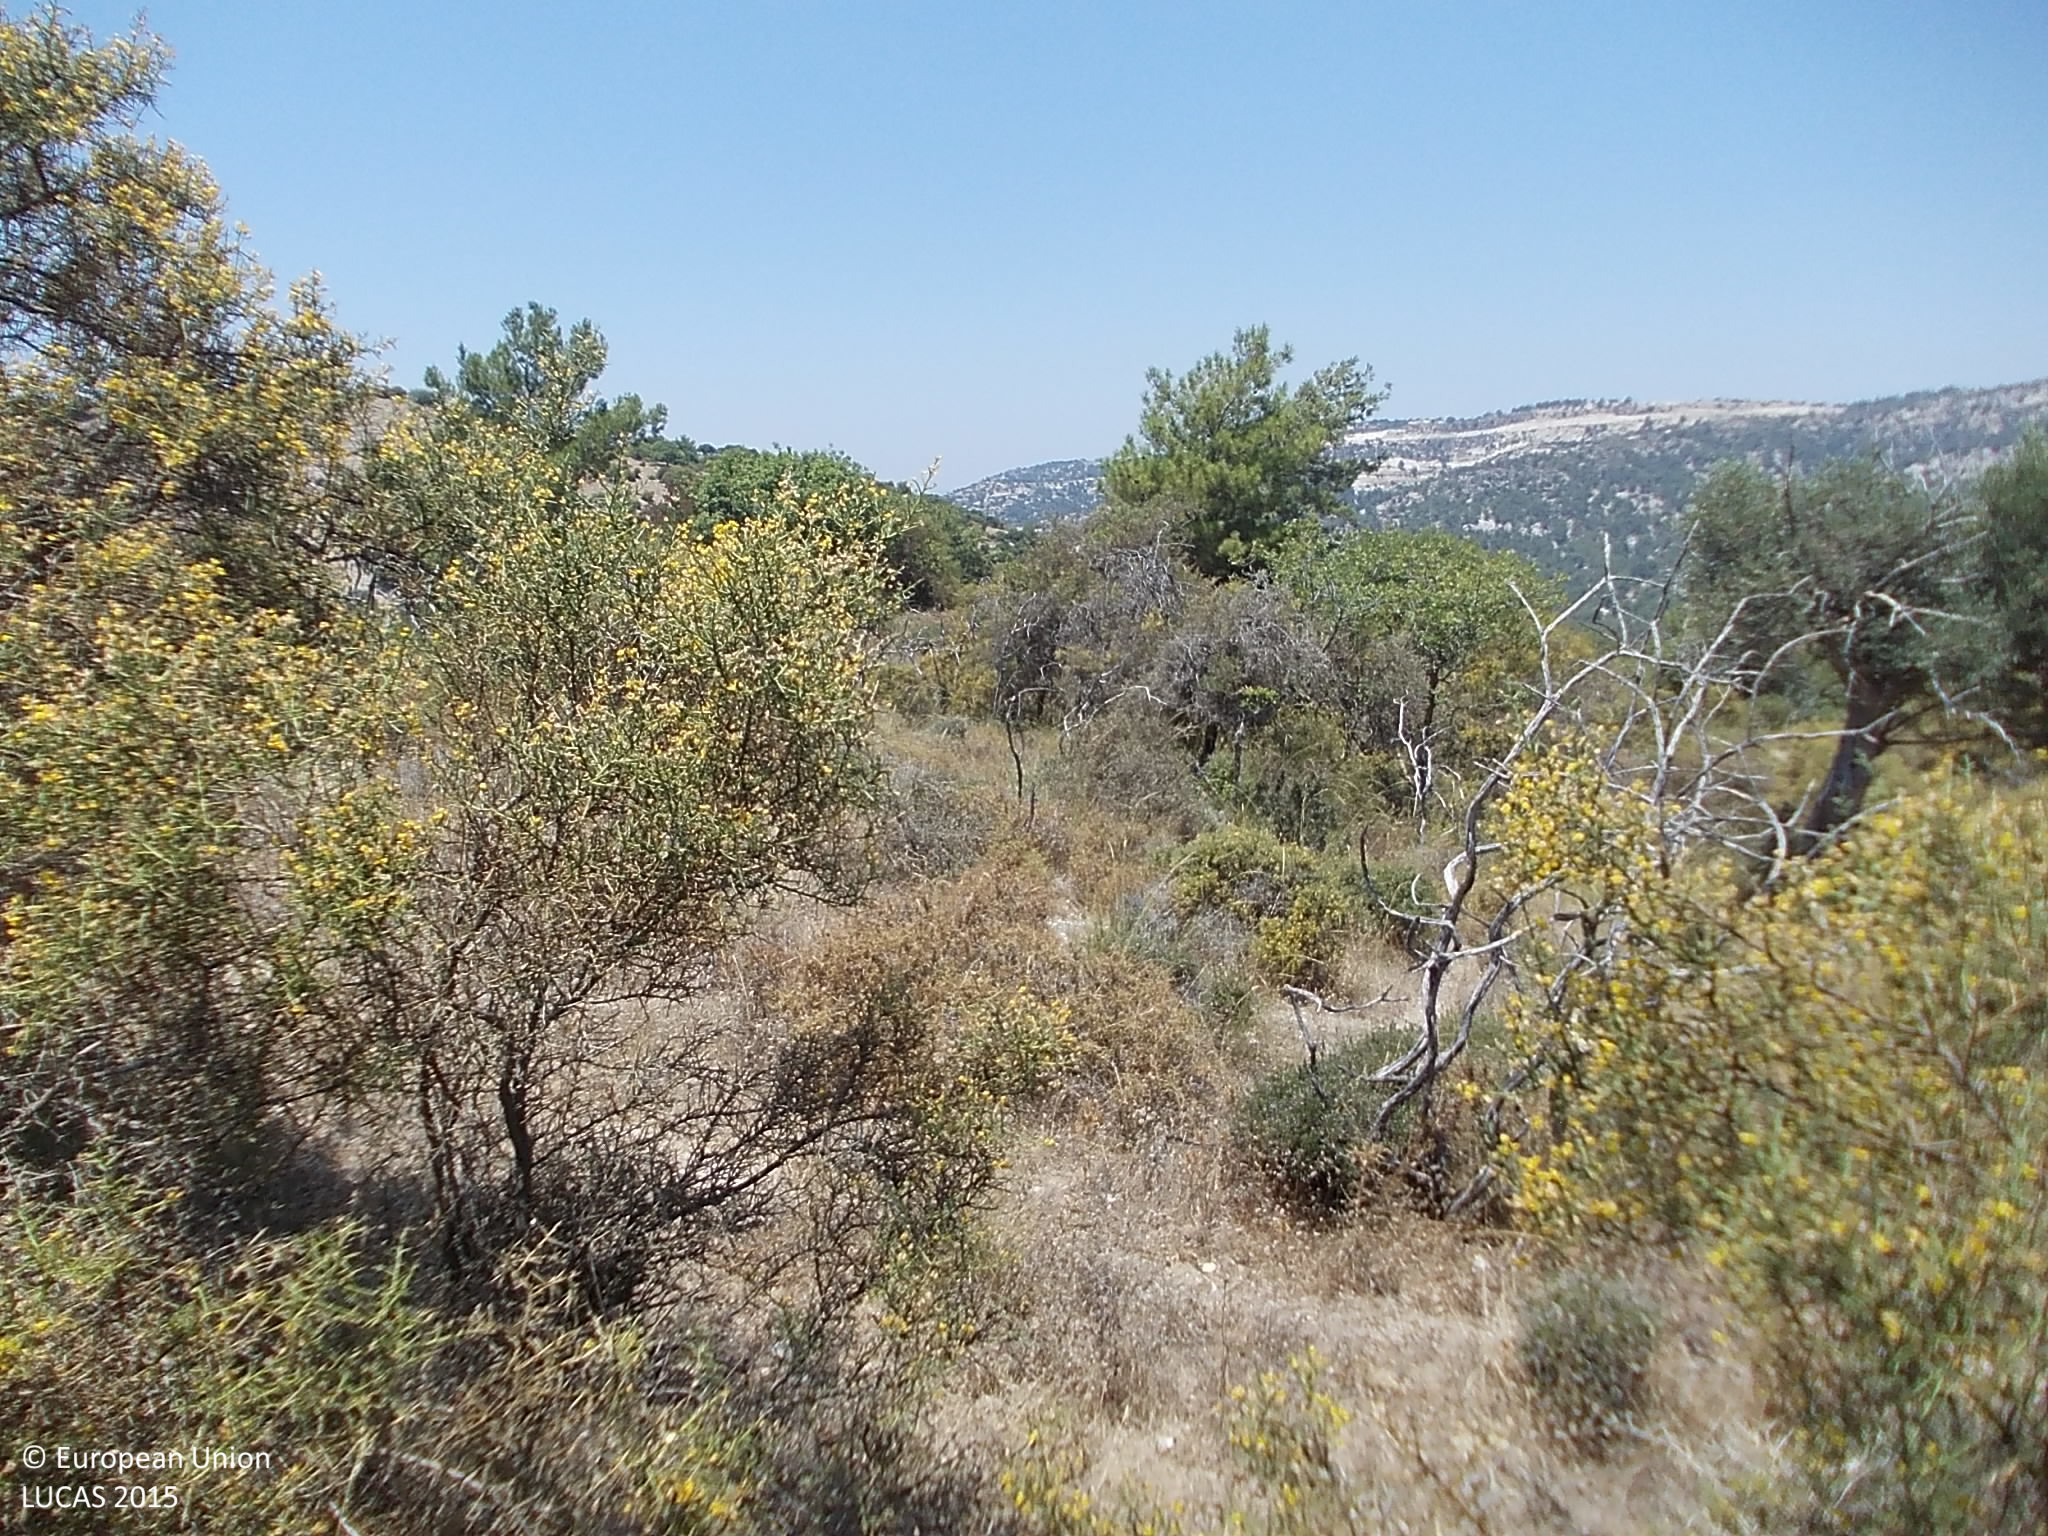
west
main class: Shrubland
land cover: Shrubland with sparse tree cover
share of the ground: 50 - 75 %
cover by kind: shrubs 65 %, herbaceous plants 15 %, unconsolidated bare surface 15 %, broadleaved forest trees 5 %
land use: Semi-natural and natural areas not in use
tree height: > 5 m
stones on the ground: 25 - 50 %
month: July
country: CY
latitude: 34.7370
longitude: 32.7077
